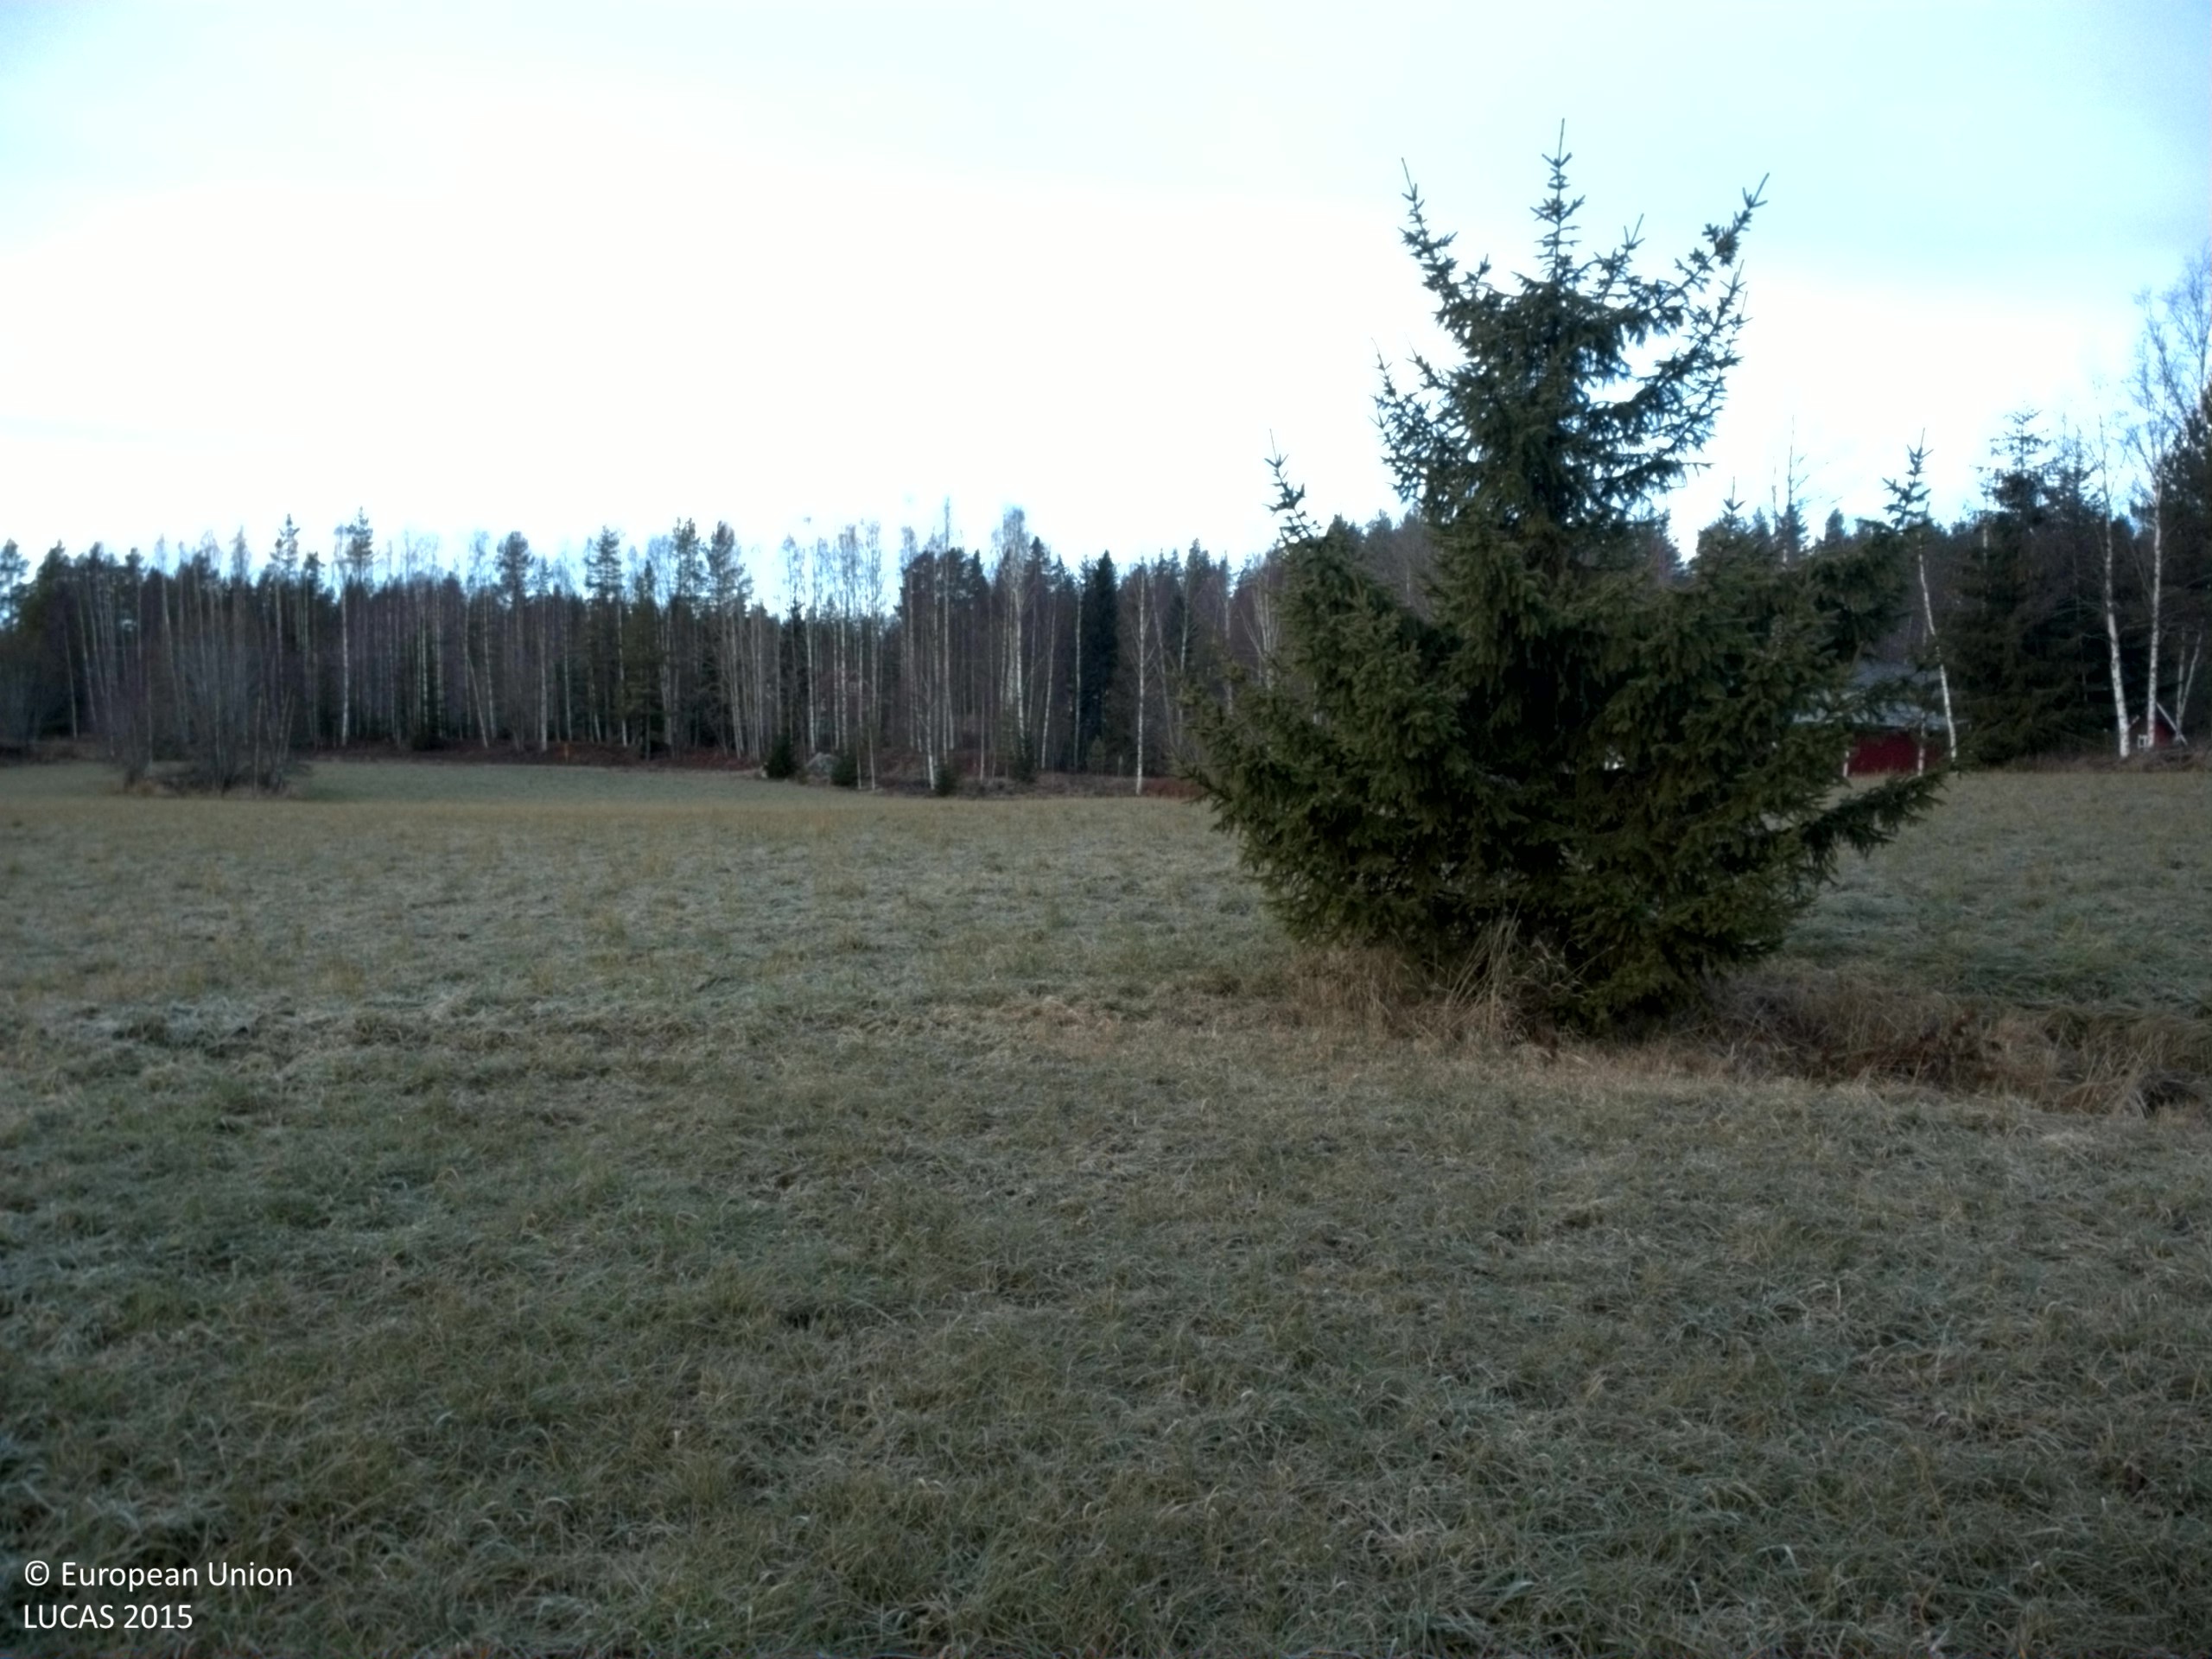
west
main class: Cropland
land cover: Other leguminous and mixtures for fodder
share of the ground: > 75 %
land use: Agriculture (excluding fallow land and kitchen gardens)
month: November
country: SE
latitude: 61.2783
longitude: 16.4954
